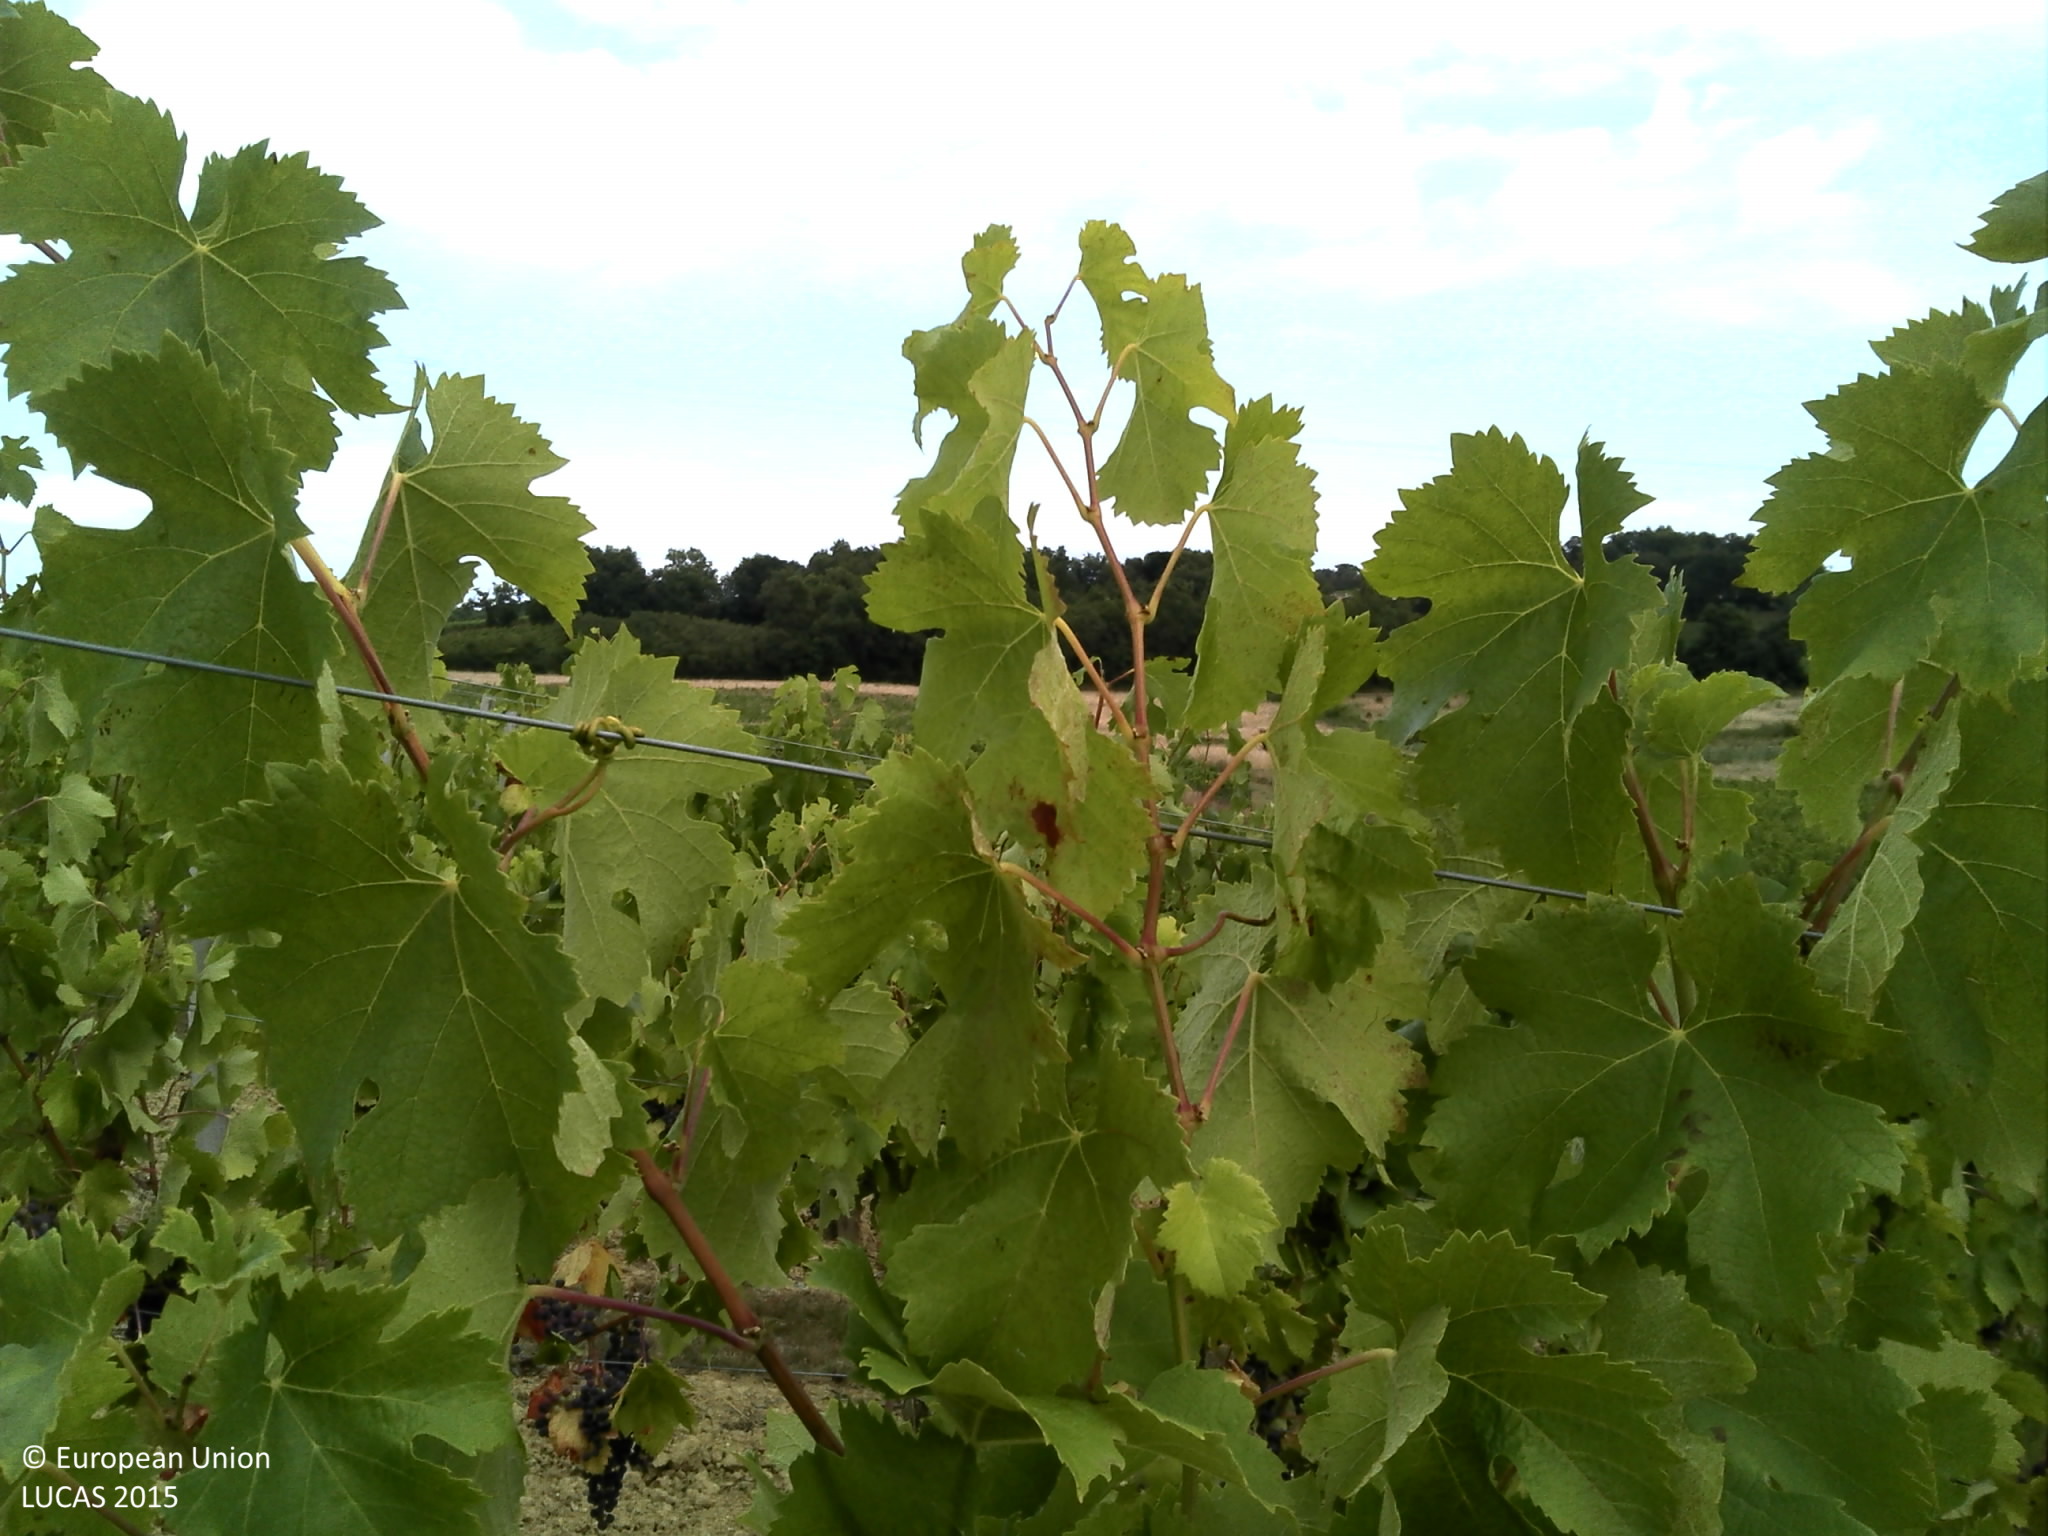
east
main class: Cropland
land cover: Vineyards
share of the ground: 10 - 25 %
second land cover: Other bare soil
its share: > 75 %
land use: Agriculture (excluding fallow land and kitchen gardens)
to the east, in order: Vineyards; Other bare soil; Managed hedges; Vineyards; Electric lines; Vineyards; Tracks; Vineyards; Tracks; Vineyards; Tracks; Grass margins; Tracks; Grassland without tree/shrub cover
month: August
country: FR
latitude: 45.0781
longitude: -0.6019
